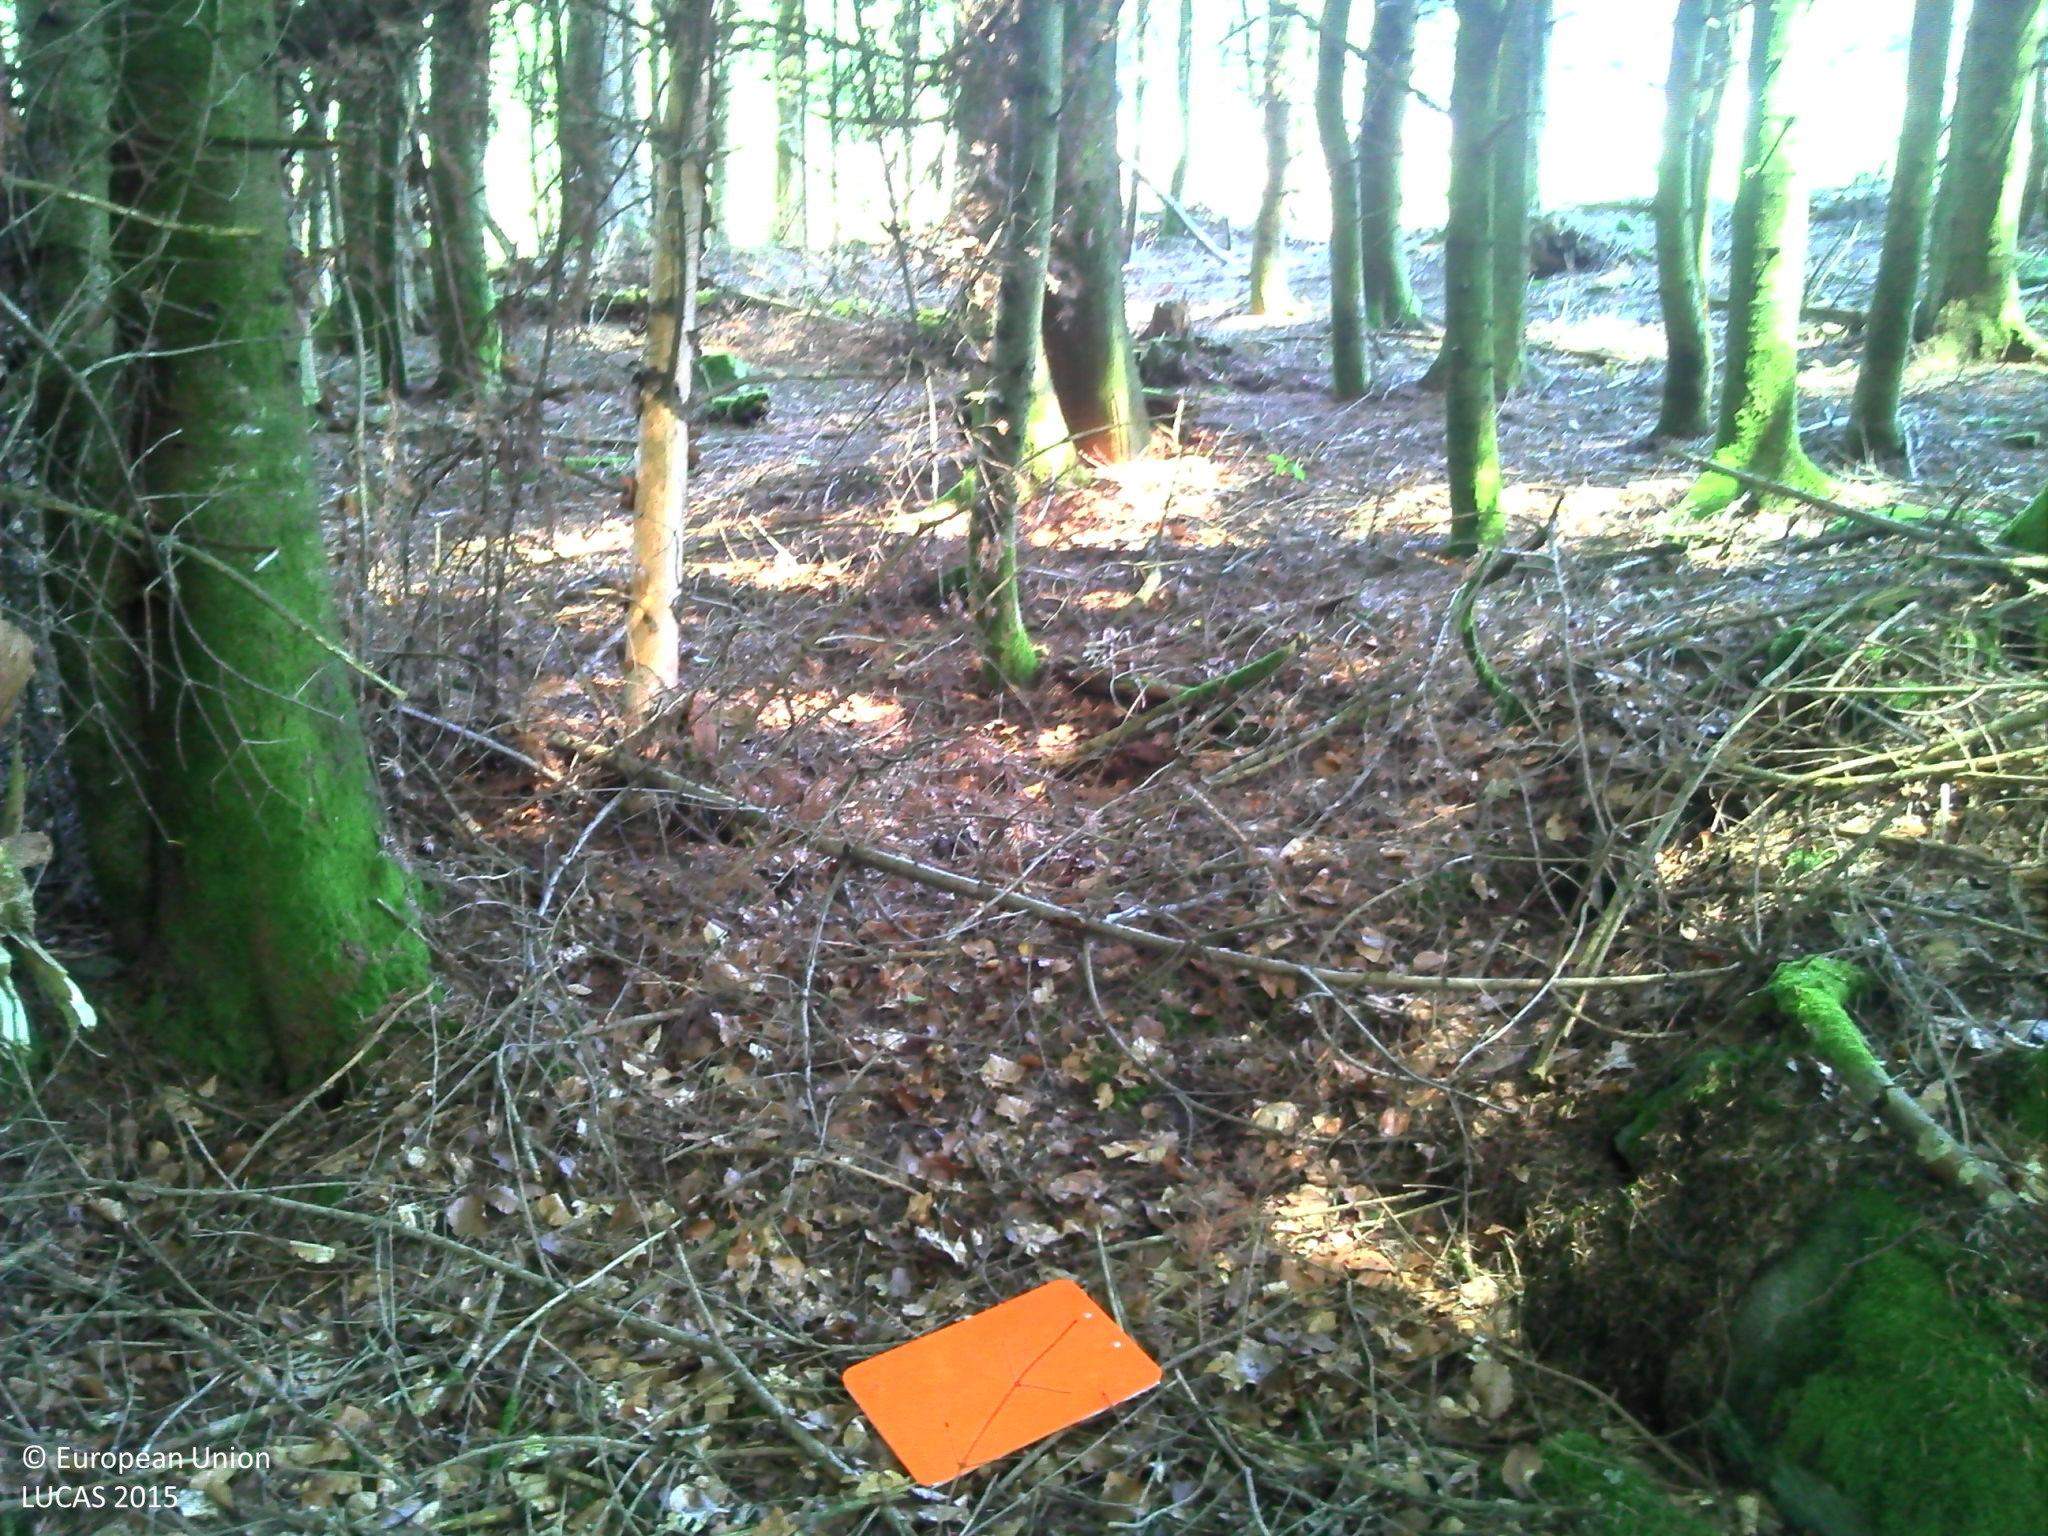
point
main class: Woodland
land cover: Spruce dominated coniferous woodland
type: hemiboreal forest and nemoral coniferous forest and mixed broadleaved-coniferous forest
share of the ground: > 75 %
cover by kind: coniferous forest trees 80 %, herbaceous plants 10 %, lichens and mosses 10 %
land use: Forestry
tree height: > 5 m
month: August
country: FR
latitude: 46.1708
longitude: 4.4455
